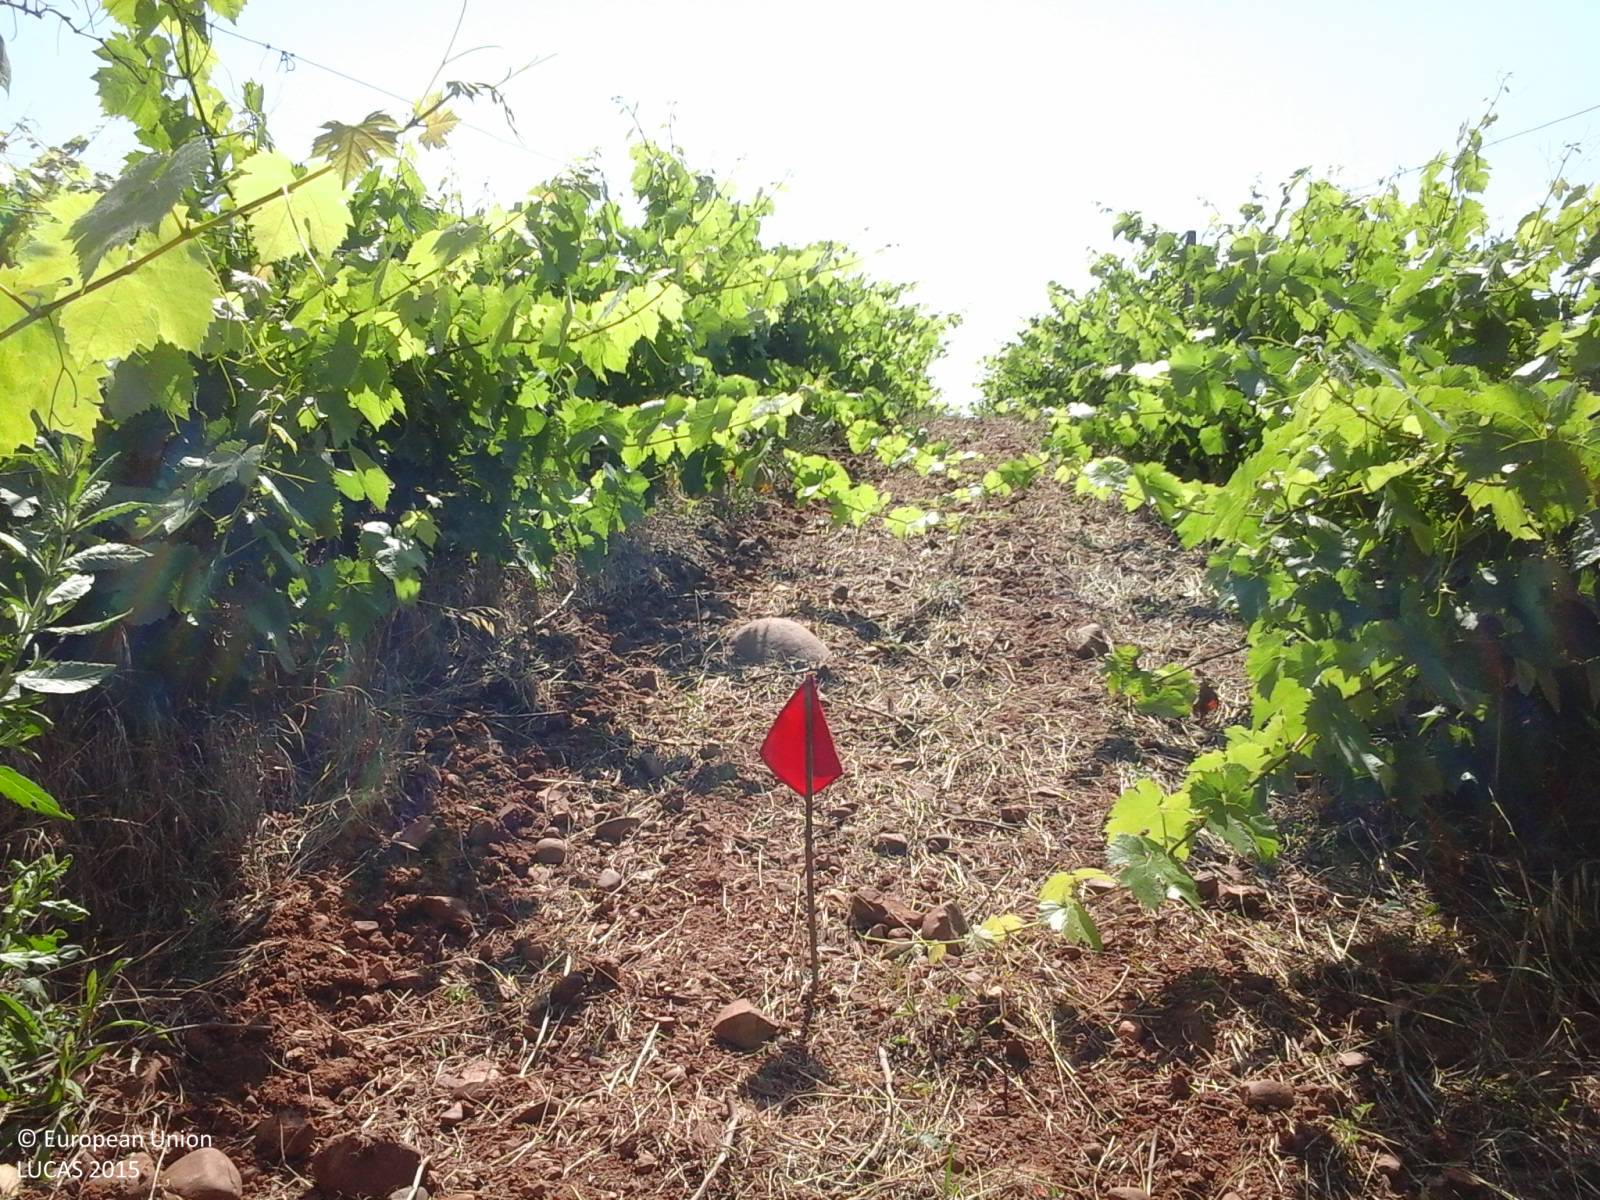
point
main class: Cropland
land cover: Vineyards
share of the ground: > 75 %
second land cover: Other bare soil
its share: > 75 %
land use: Agriculture (excluding fallow land and kitchen gardens)
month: June
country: IT
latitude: 37.9714
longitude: 13.0403
